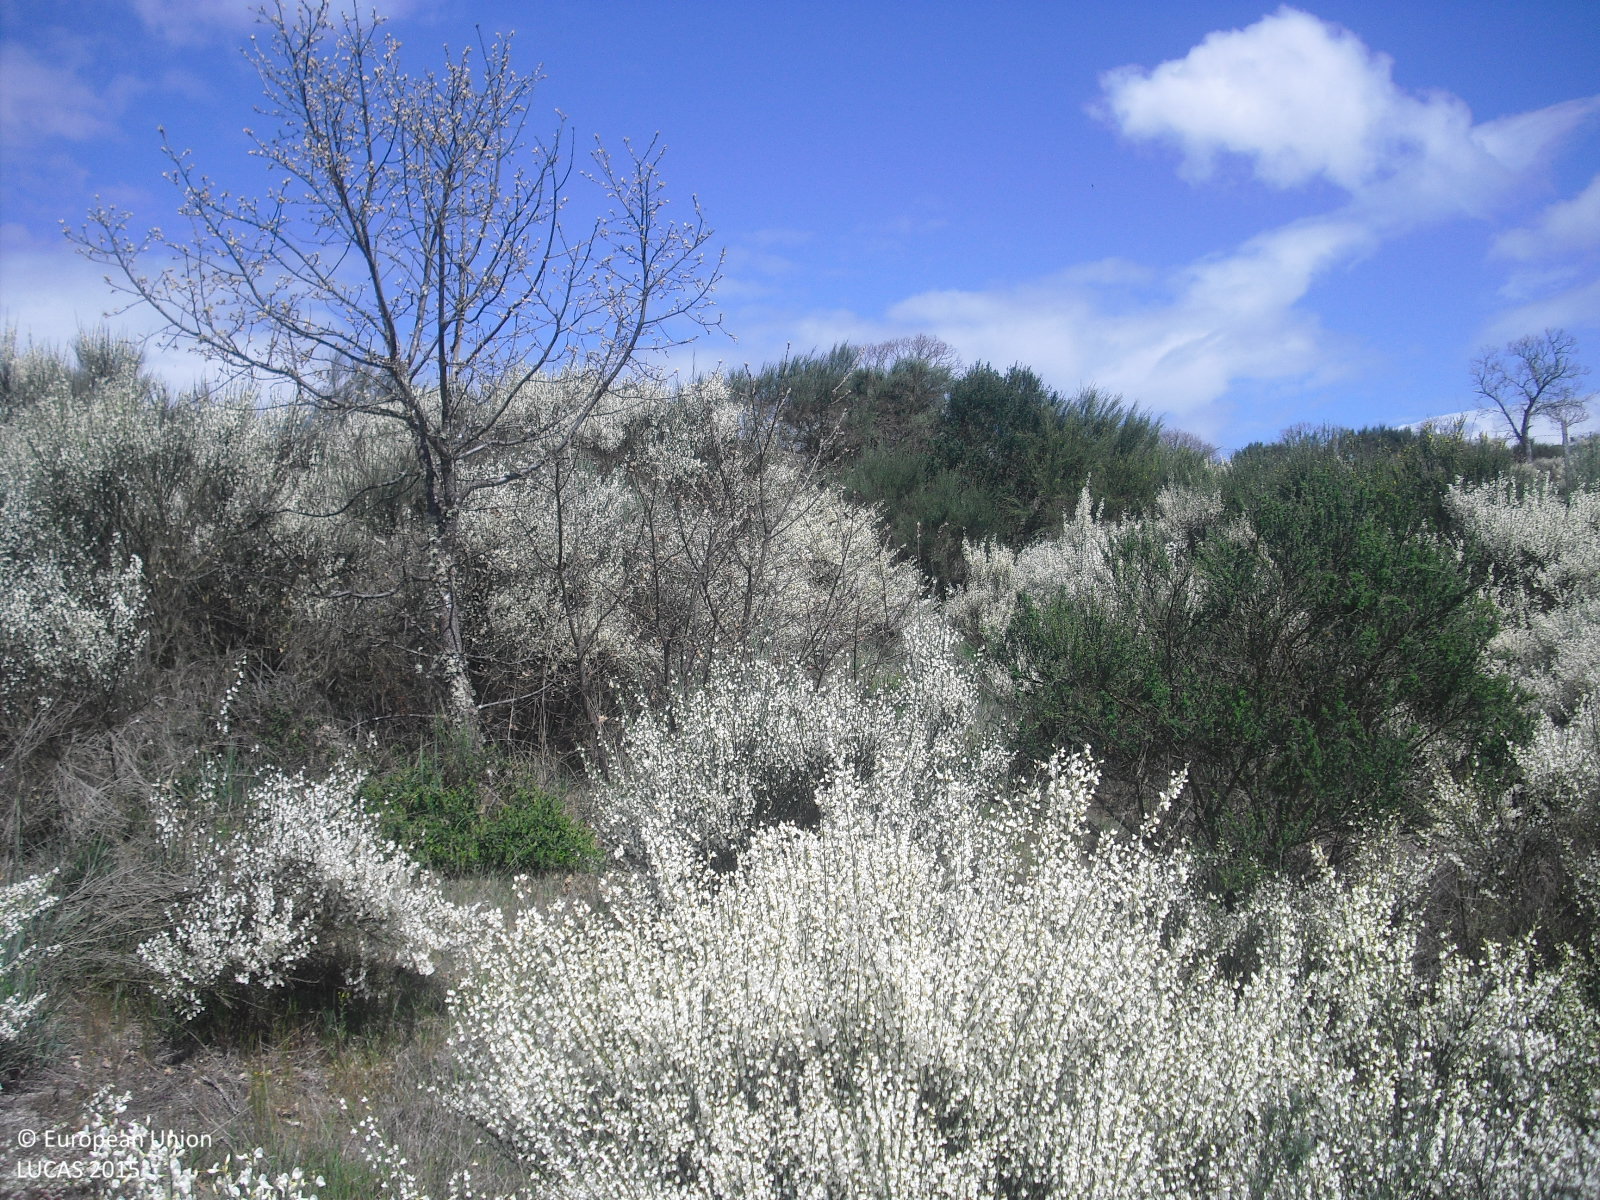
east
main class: Shrubland
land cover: Shrubland with sparse tree cover
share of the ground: 50 - 75 %
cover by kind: shrubs 70 %, herbaceous plants 15 %, consolidated bare surface 10 %, broadleaved forest trees 5 %
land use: Semi-natural and natural areas not in use
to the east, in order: Shrubland with sparse tree cover; Shrubland without tree cover; Rock outcrops; Grassland with sparse tree/shrub cover; Tracks; Shrubland without tree cover; Rock outcrops; Shrubland without tree cover; Dry stone walls; Shrubland without tree cover; Other bare soil; Nuts trees; Other bare soil; Grass margins; Artificial constructions; Nuts trees; Dry stone walls; Ditches and canals; Grass margins; Paved roads, cycling and walking lanes; Grass margins; Ditches and canals; Shrubland without tree cover; Rock outcrops
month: April
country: ES
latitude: 41.8565
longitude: -7.5894
